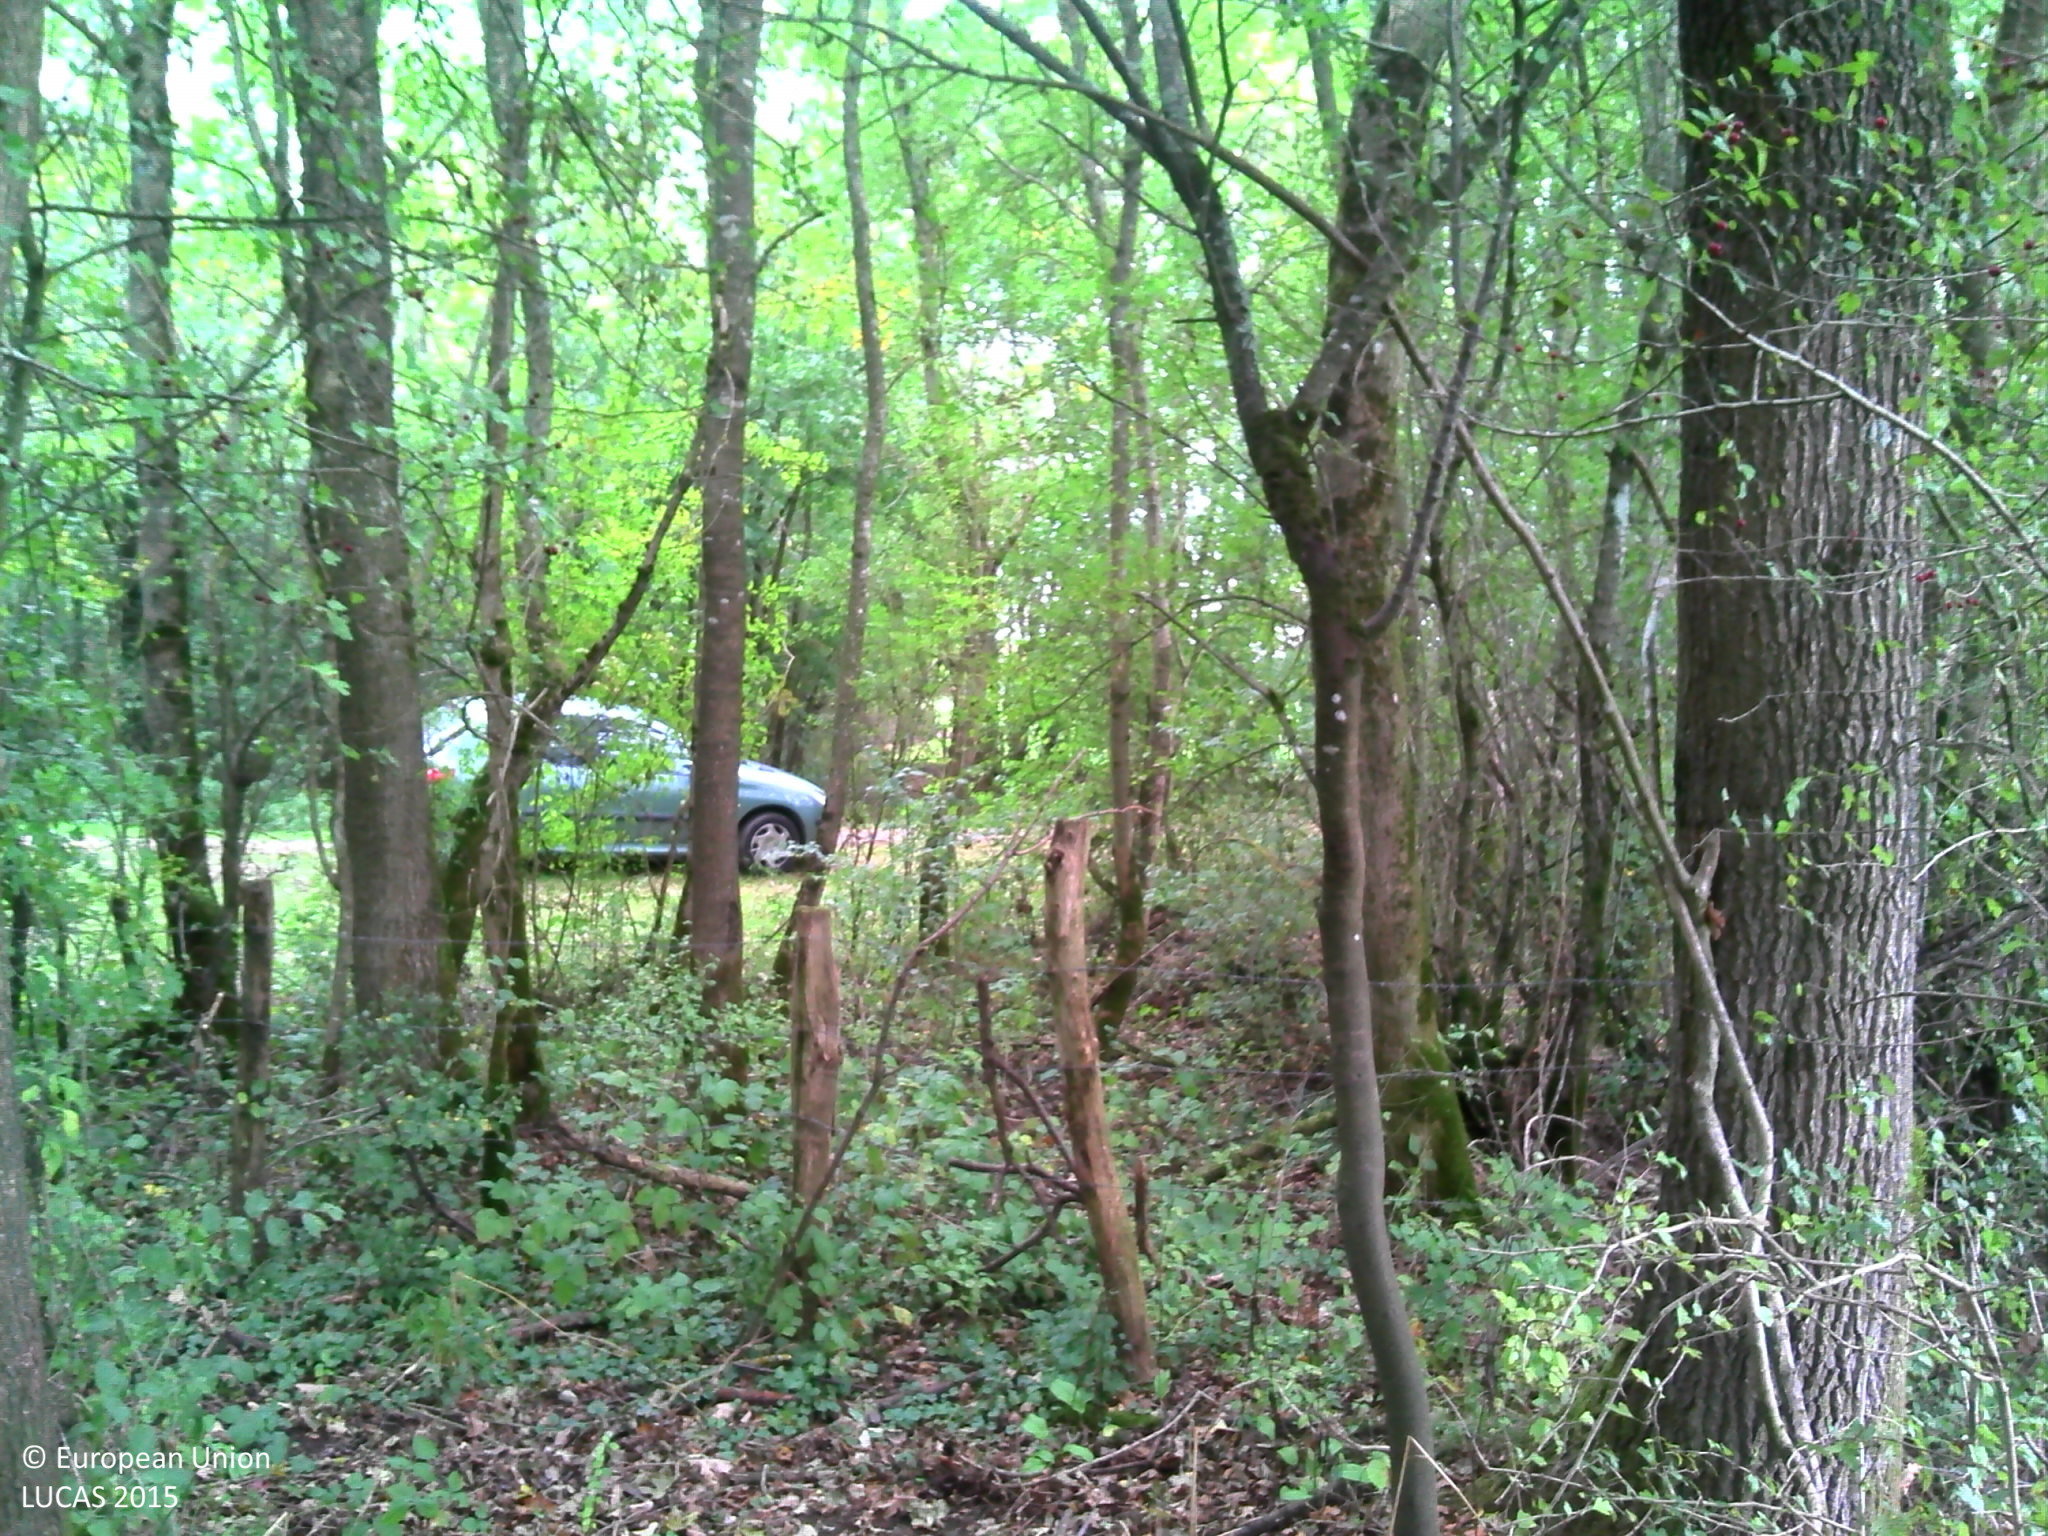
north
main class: Woodland
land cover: Broadleaved woodland
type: mesophytic deciduous forest
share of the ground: > 75 %
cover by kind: broadleaved forest trees 90 %, shrubs 10 %
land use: Forestry
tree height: > 5 m
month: October
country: FR
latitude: 46.5031
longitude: 4.9591
